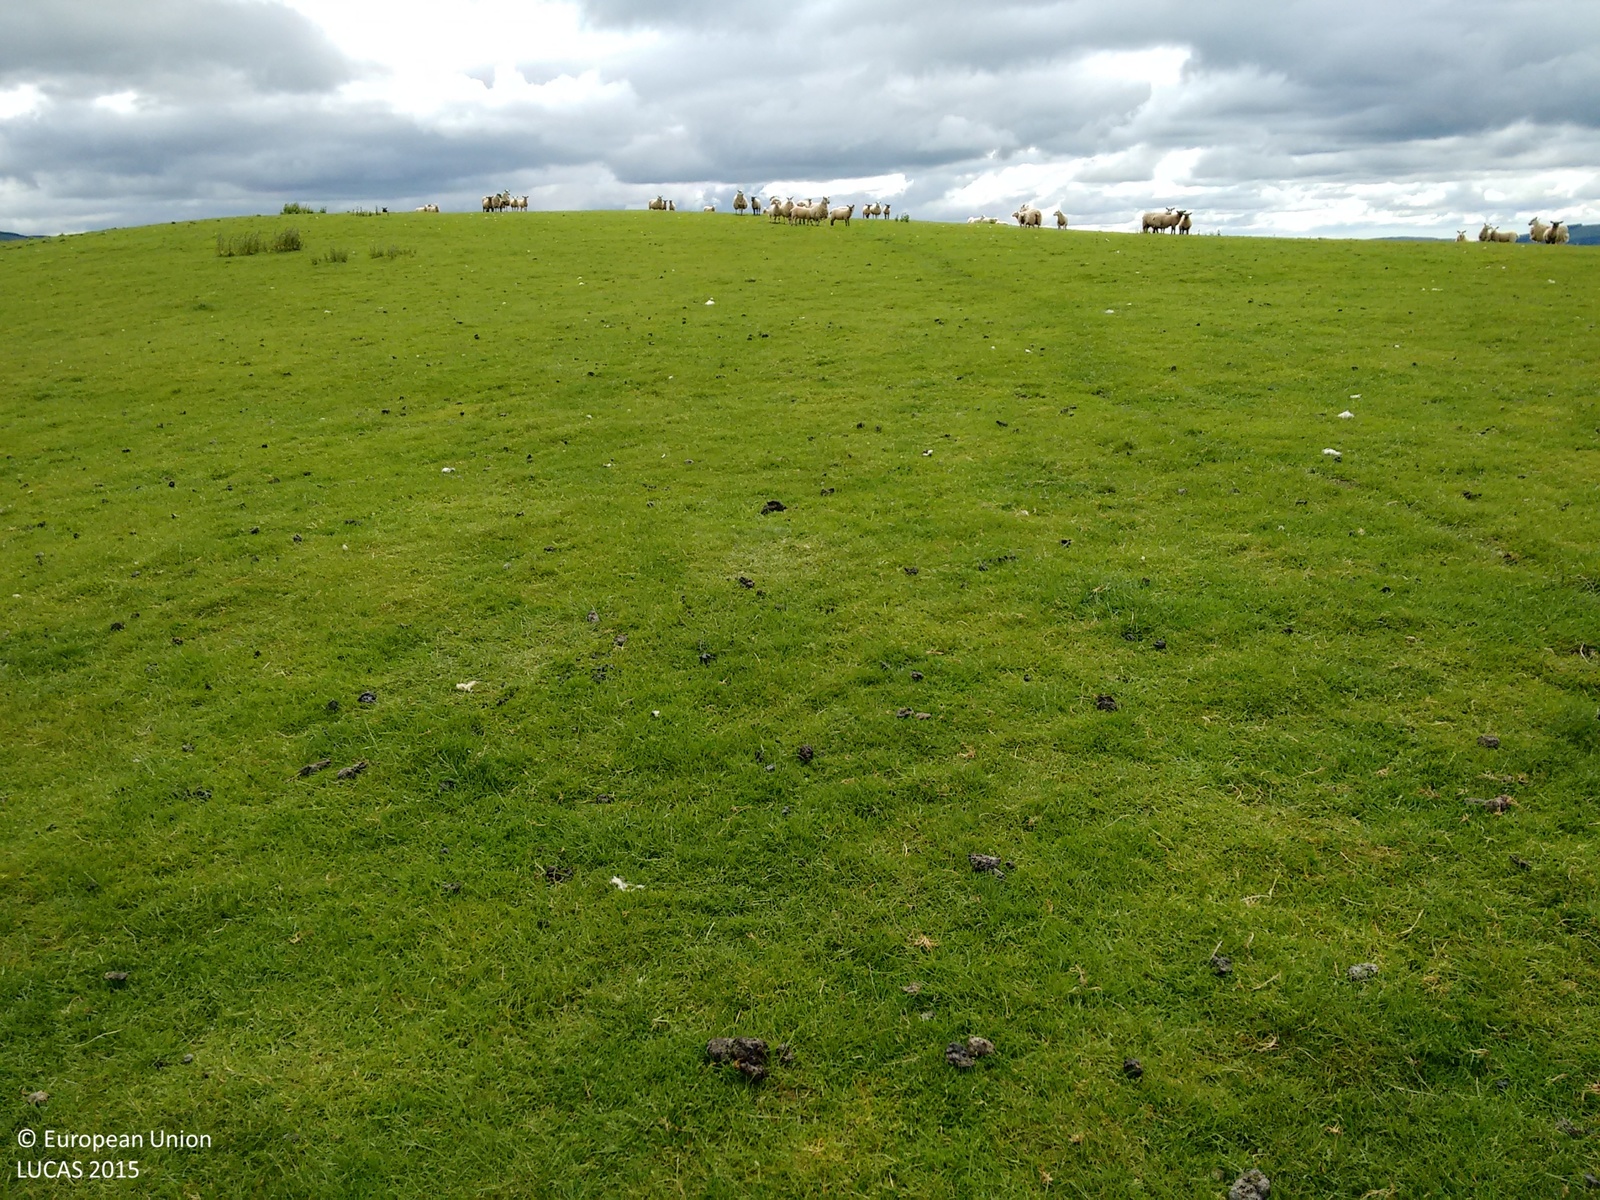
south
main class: Grassland
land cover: Grassland without tree/shrub cover
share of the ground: > 75 %
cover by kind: herbaceous plants 100 %
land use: Agriculture (excluding fallow land and kitchen gardens)
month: June
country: GB
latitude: 55.2591
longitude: -3.7584
